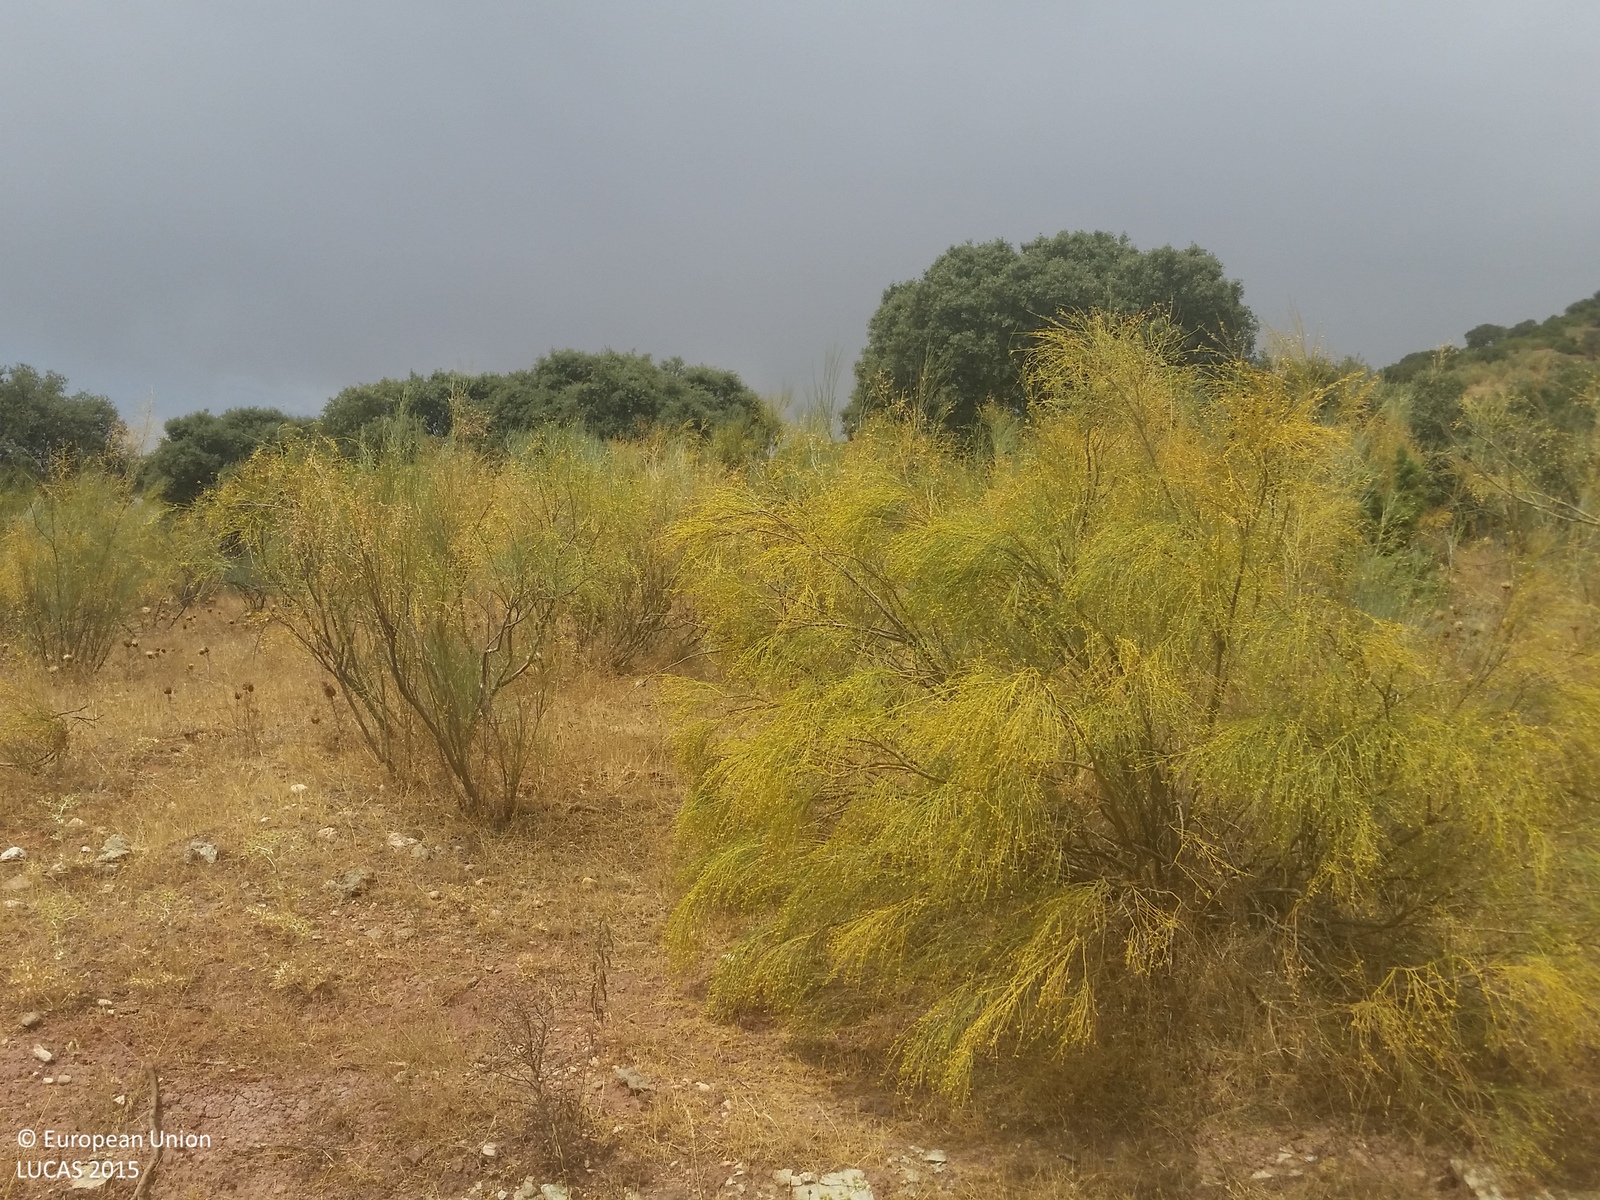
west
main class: Woodland
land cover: Broadleaved woodland
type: acidophilous oak and oak-birch forest
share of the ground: 50 - 75 %
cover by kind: broadleaved forest trees 50 %, shrubs 20 %, herbaceous plants 15 %, consolidated bare surface 15 %
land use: Semi-natural and natural areas not in use
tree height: < 5 m
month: August
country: ES
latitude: 38.6812
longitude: -2.4736
